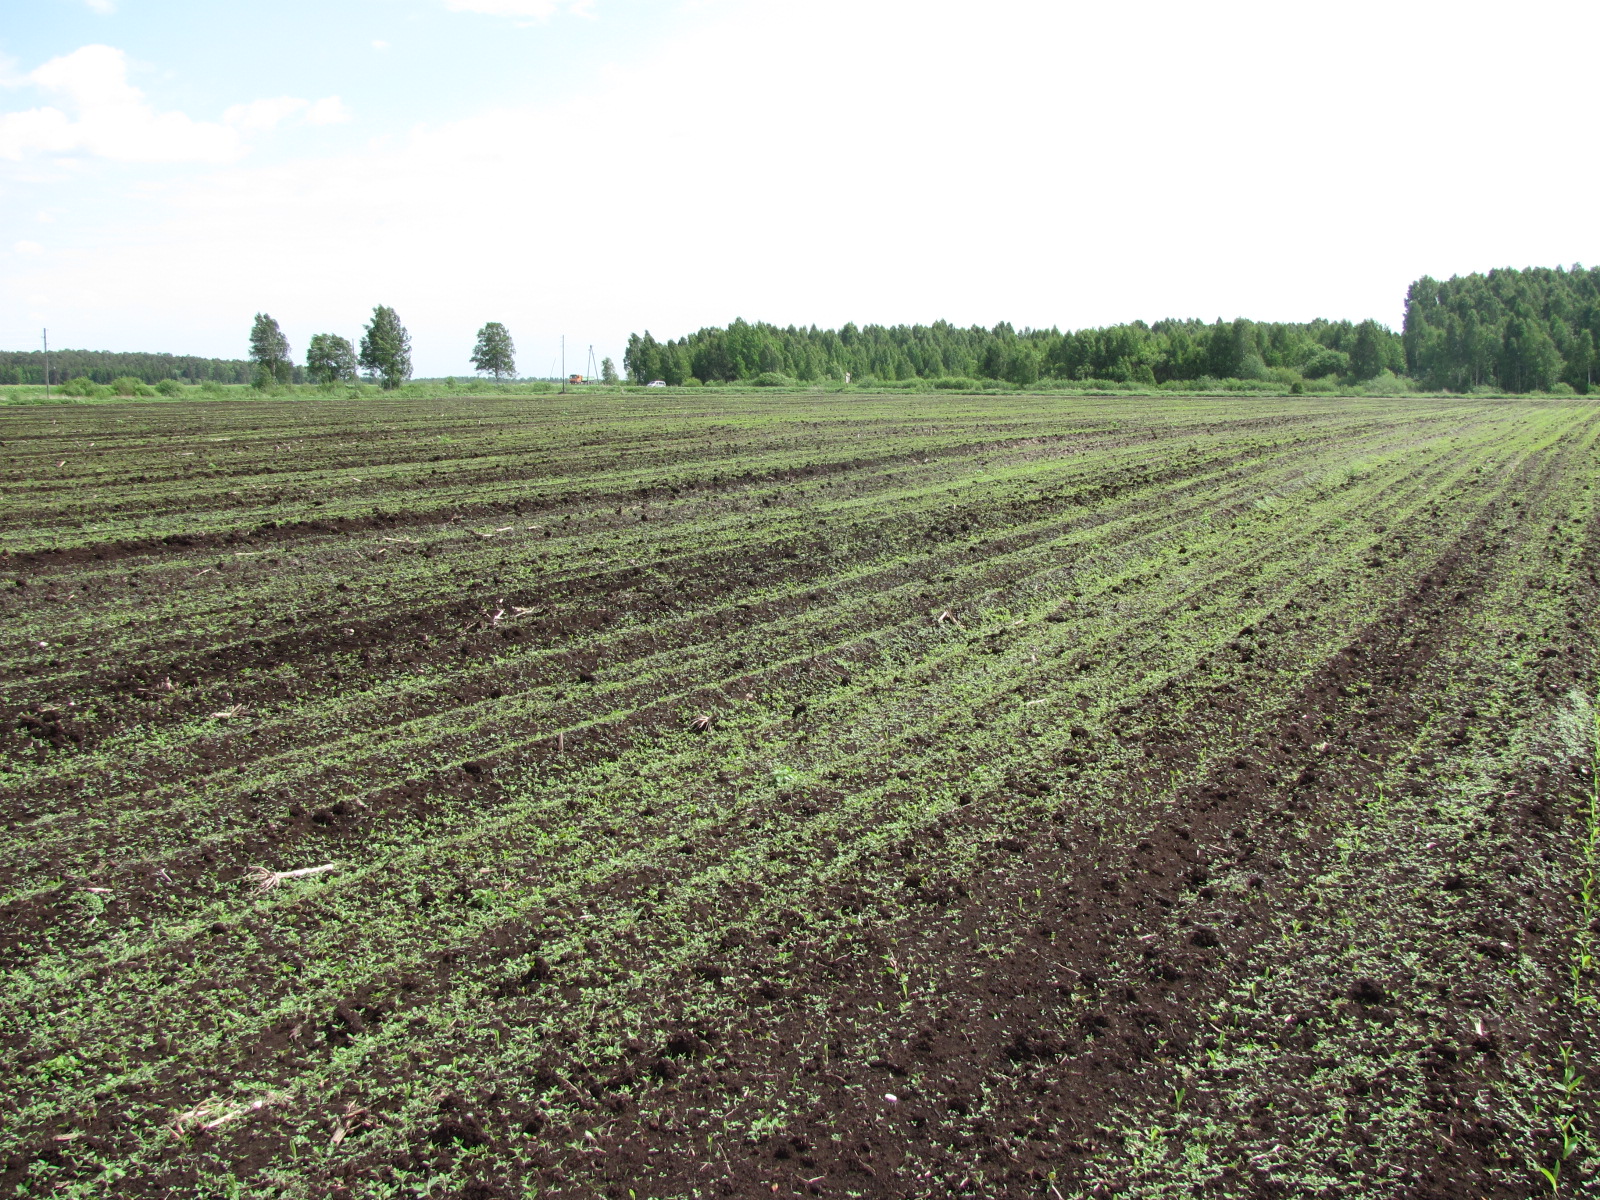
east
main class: Cropland
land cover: Maize
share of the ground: < 10 %
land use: Agriculture (excluding fallow land and kitchen gardens)
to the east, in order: Maize
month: June
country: LV
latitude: 56.8622
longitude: 23.9755
